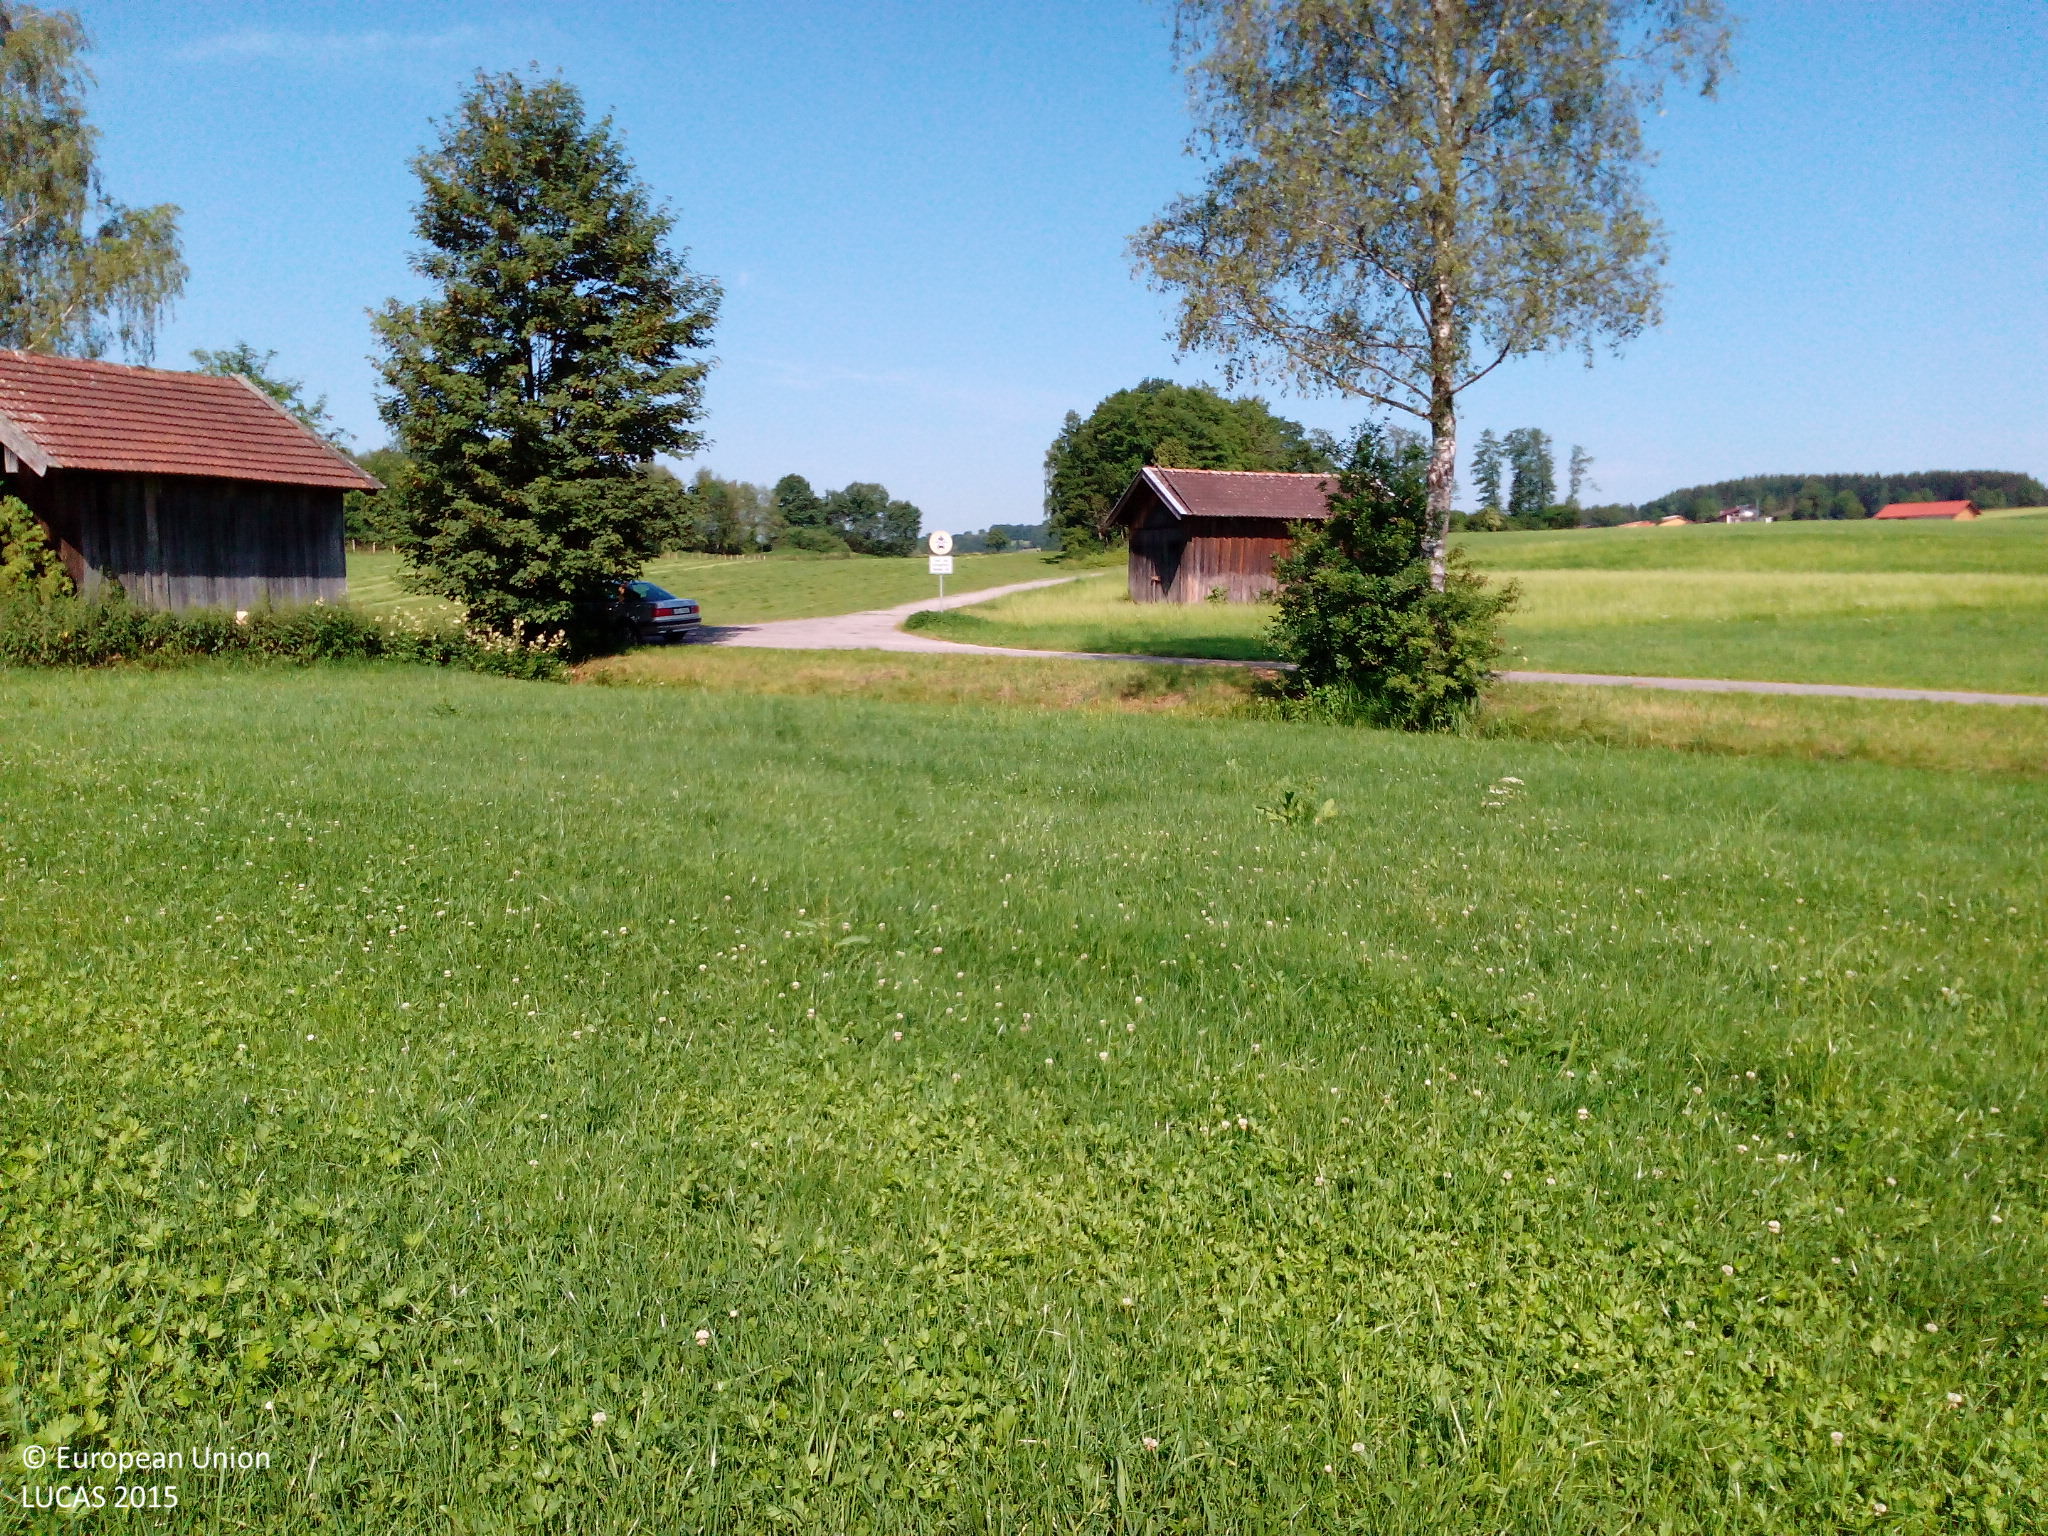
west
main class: Grassland
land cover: Grassland without tree/shrub cover
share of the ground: > 75 %
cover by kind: herbaceous plants 100 %
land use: Agriculture (excluding fallow land and kitchen gardens)
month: July
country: DE
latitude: 47.7293
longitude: 11.3457
